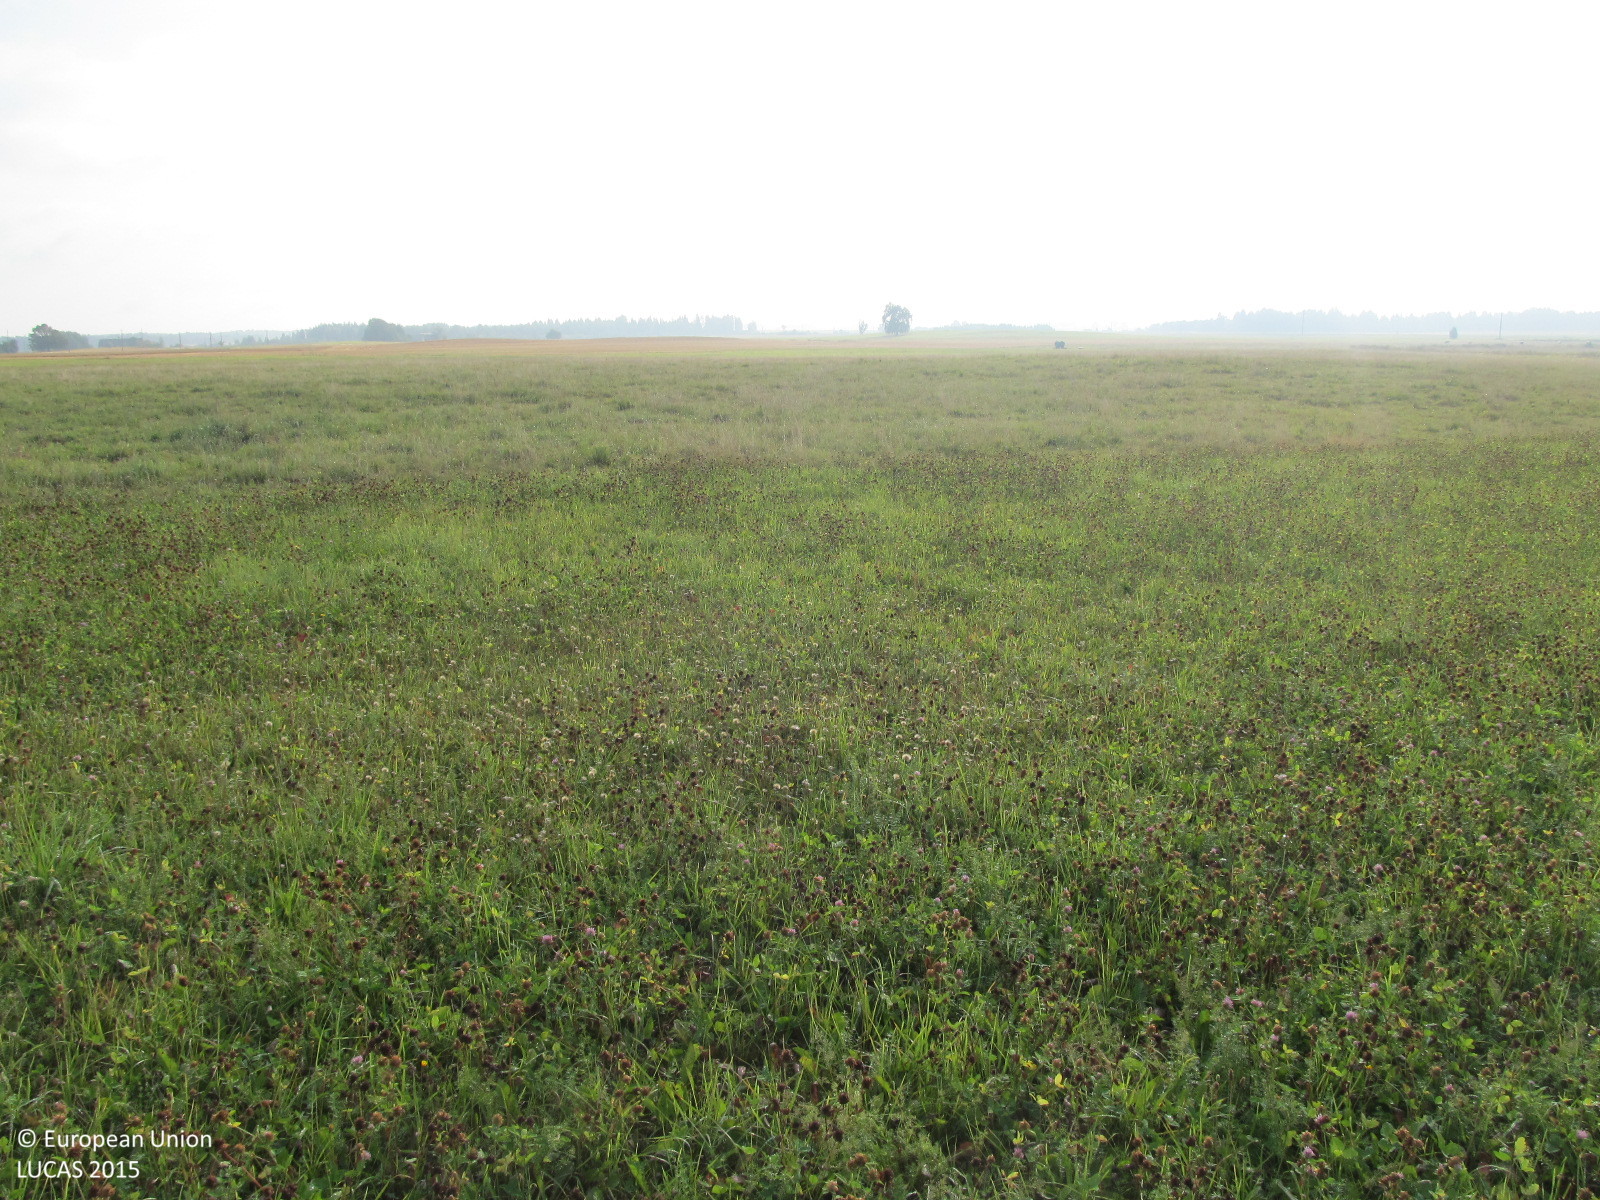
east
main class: Cropland
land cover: Clovers
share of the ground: > 75 %
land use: Agriculture (excluding fallow land and kitchen gardens)
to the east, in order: Clovers; Grassland without tree/shrub cover
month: August
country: LT
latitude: 55.6574
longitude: 23.2824
